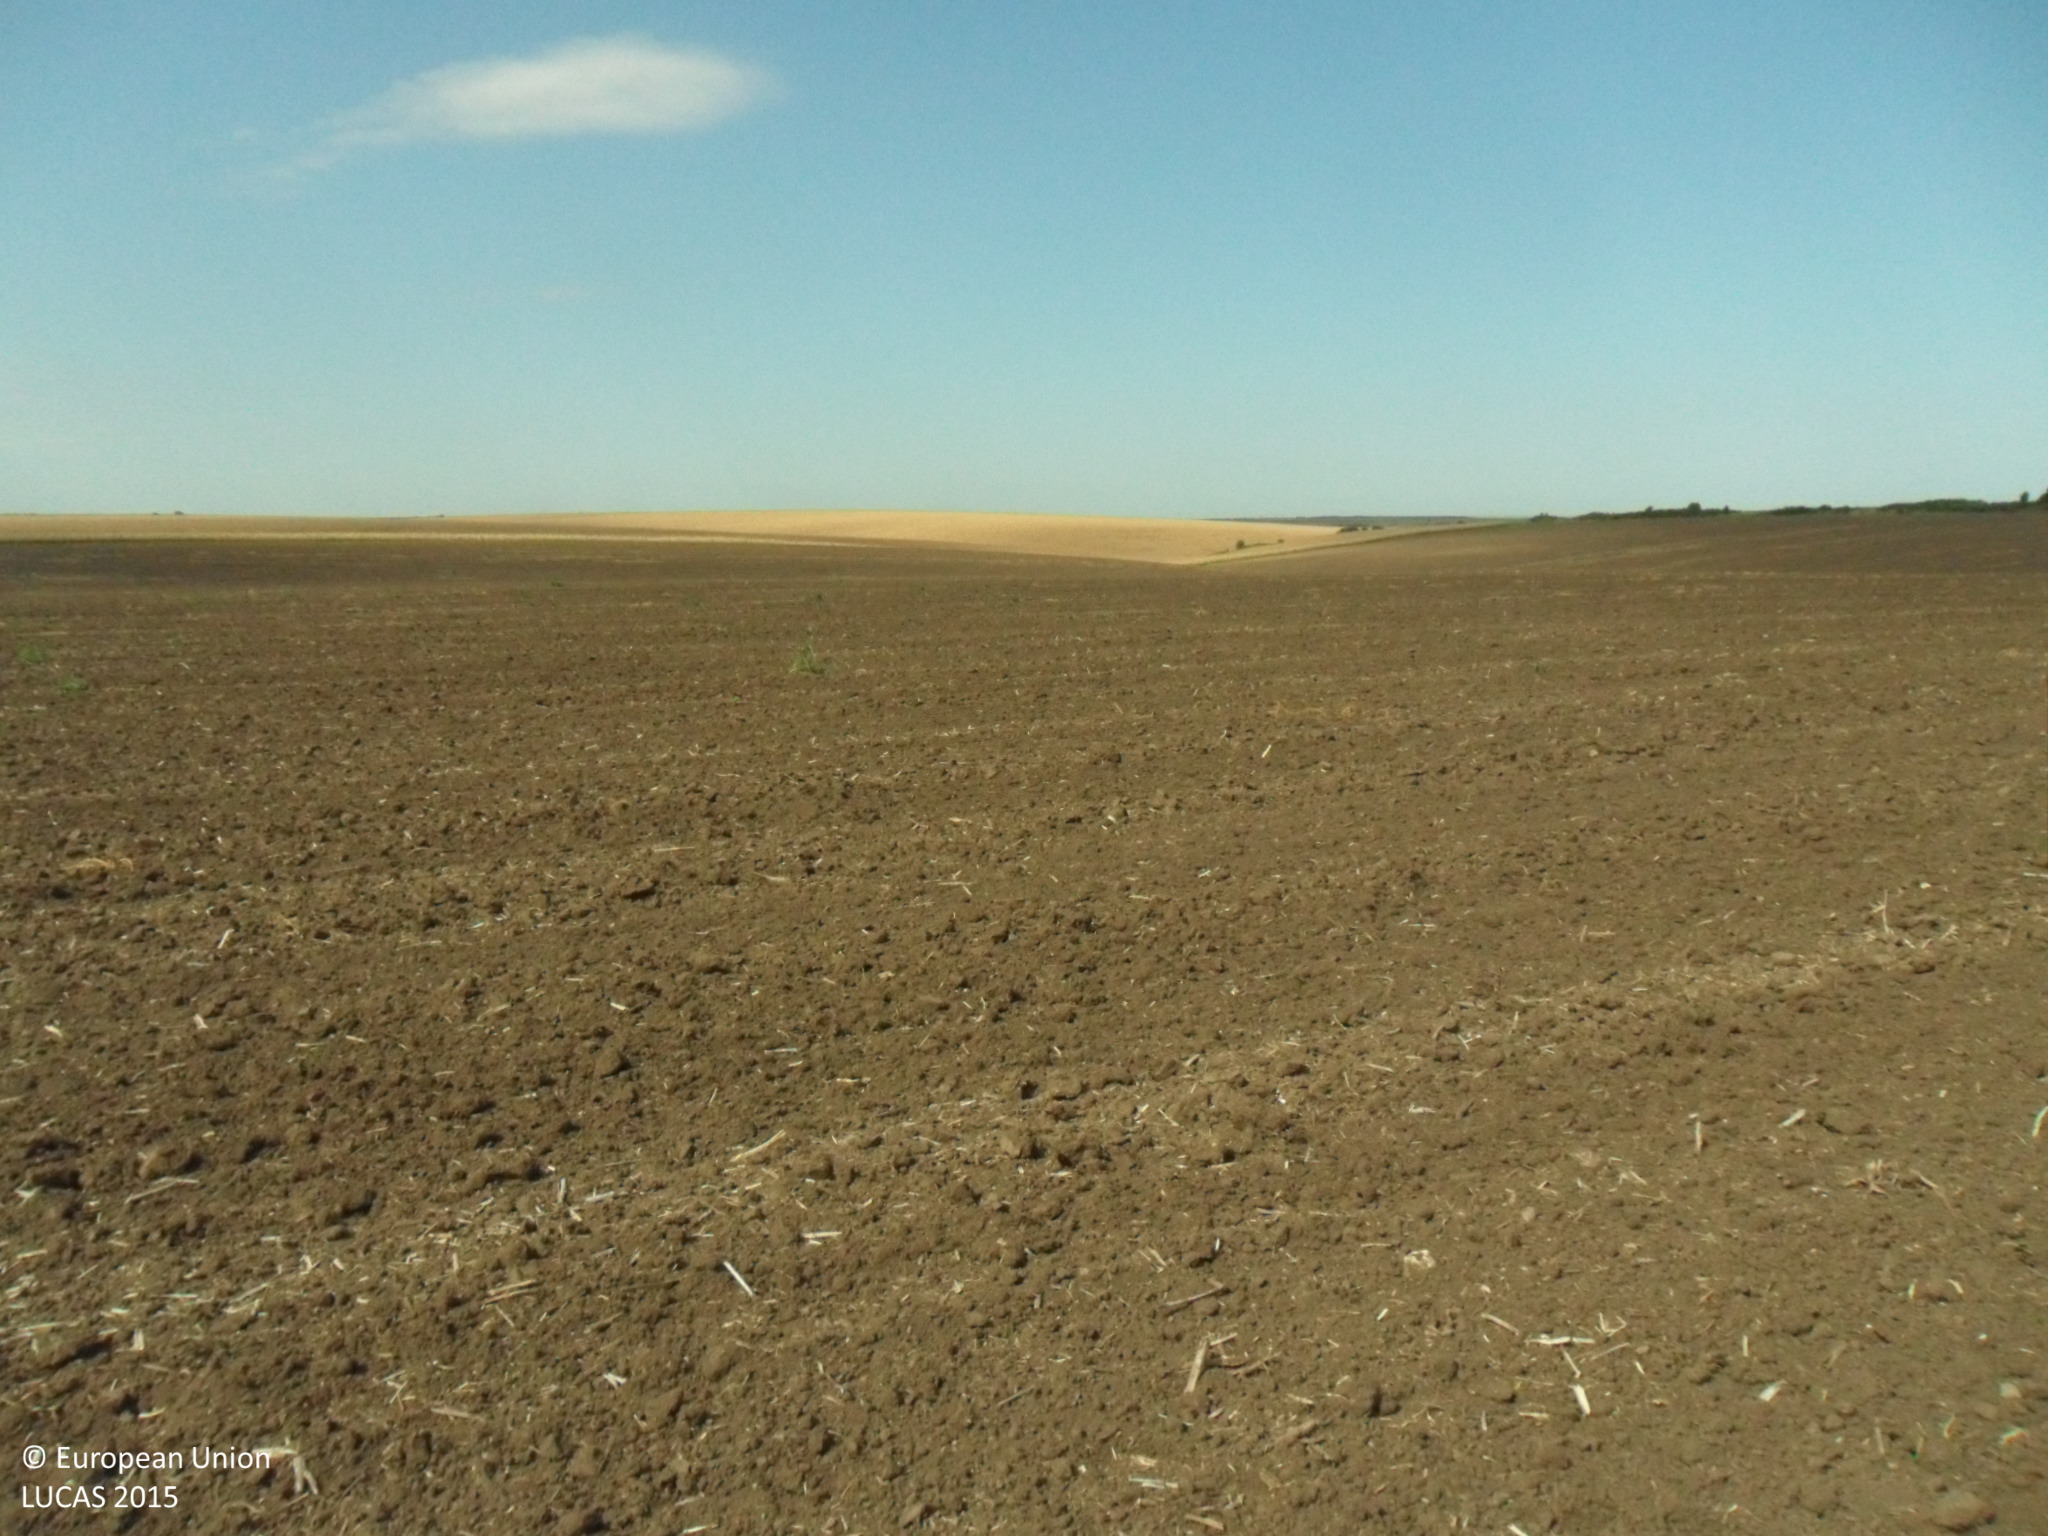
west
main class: Cropland
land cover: Sunflower
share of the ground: < 10 %
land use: Agriculture (excluding fallow land and kitchen gardens)
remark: Harvested field
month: September
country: BG
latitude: 43.9468
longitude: 26.4430
